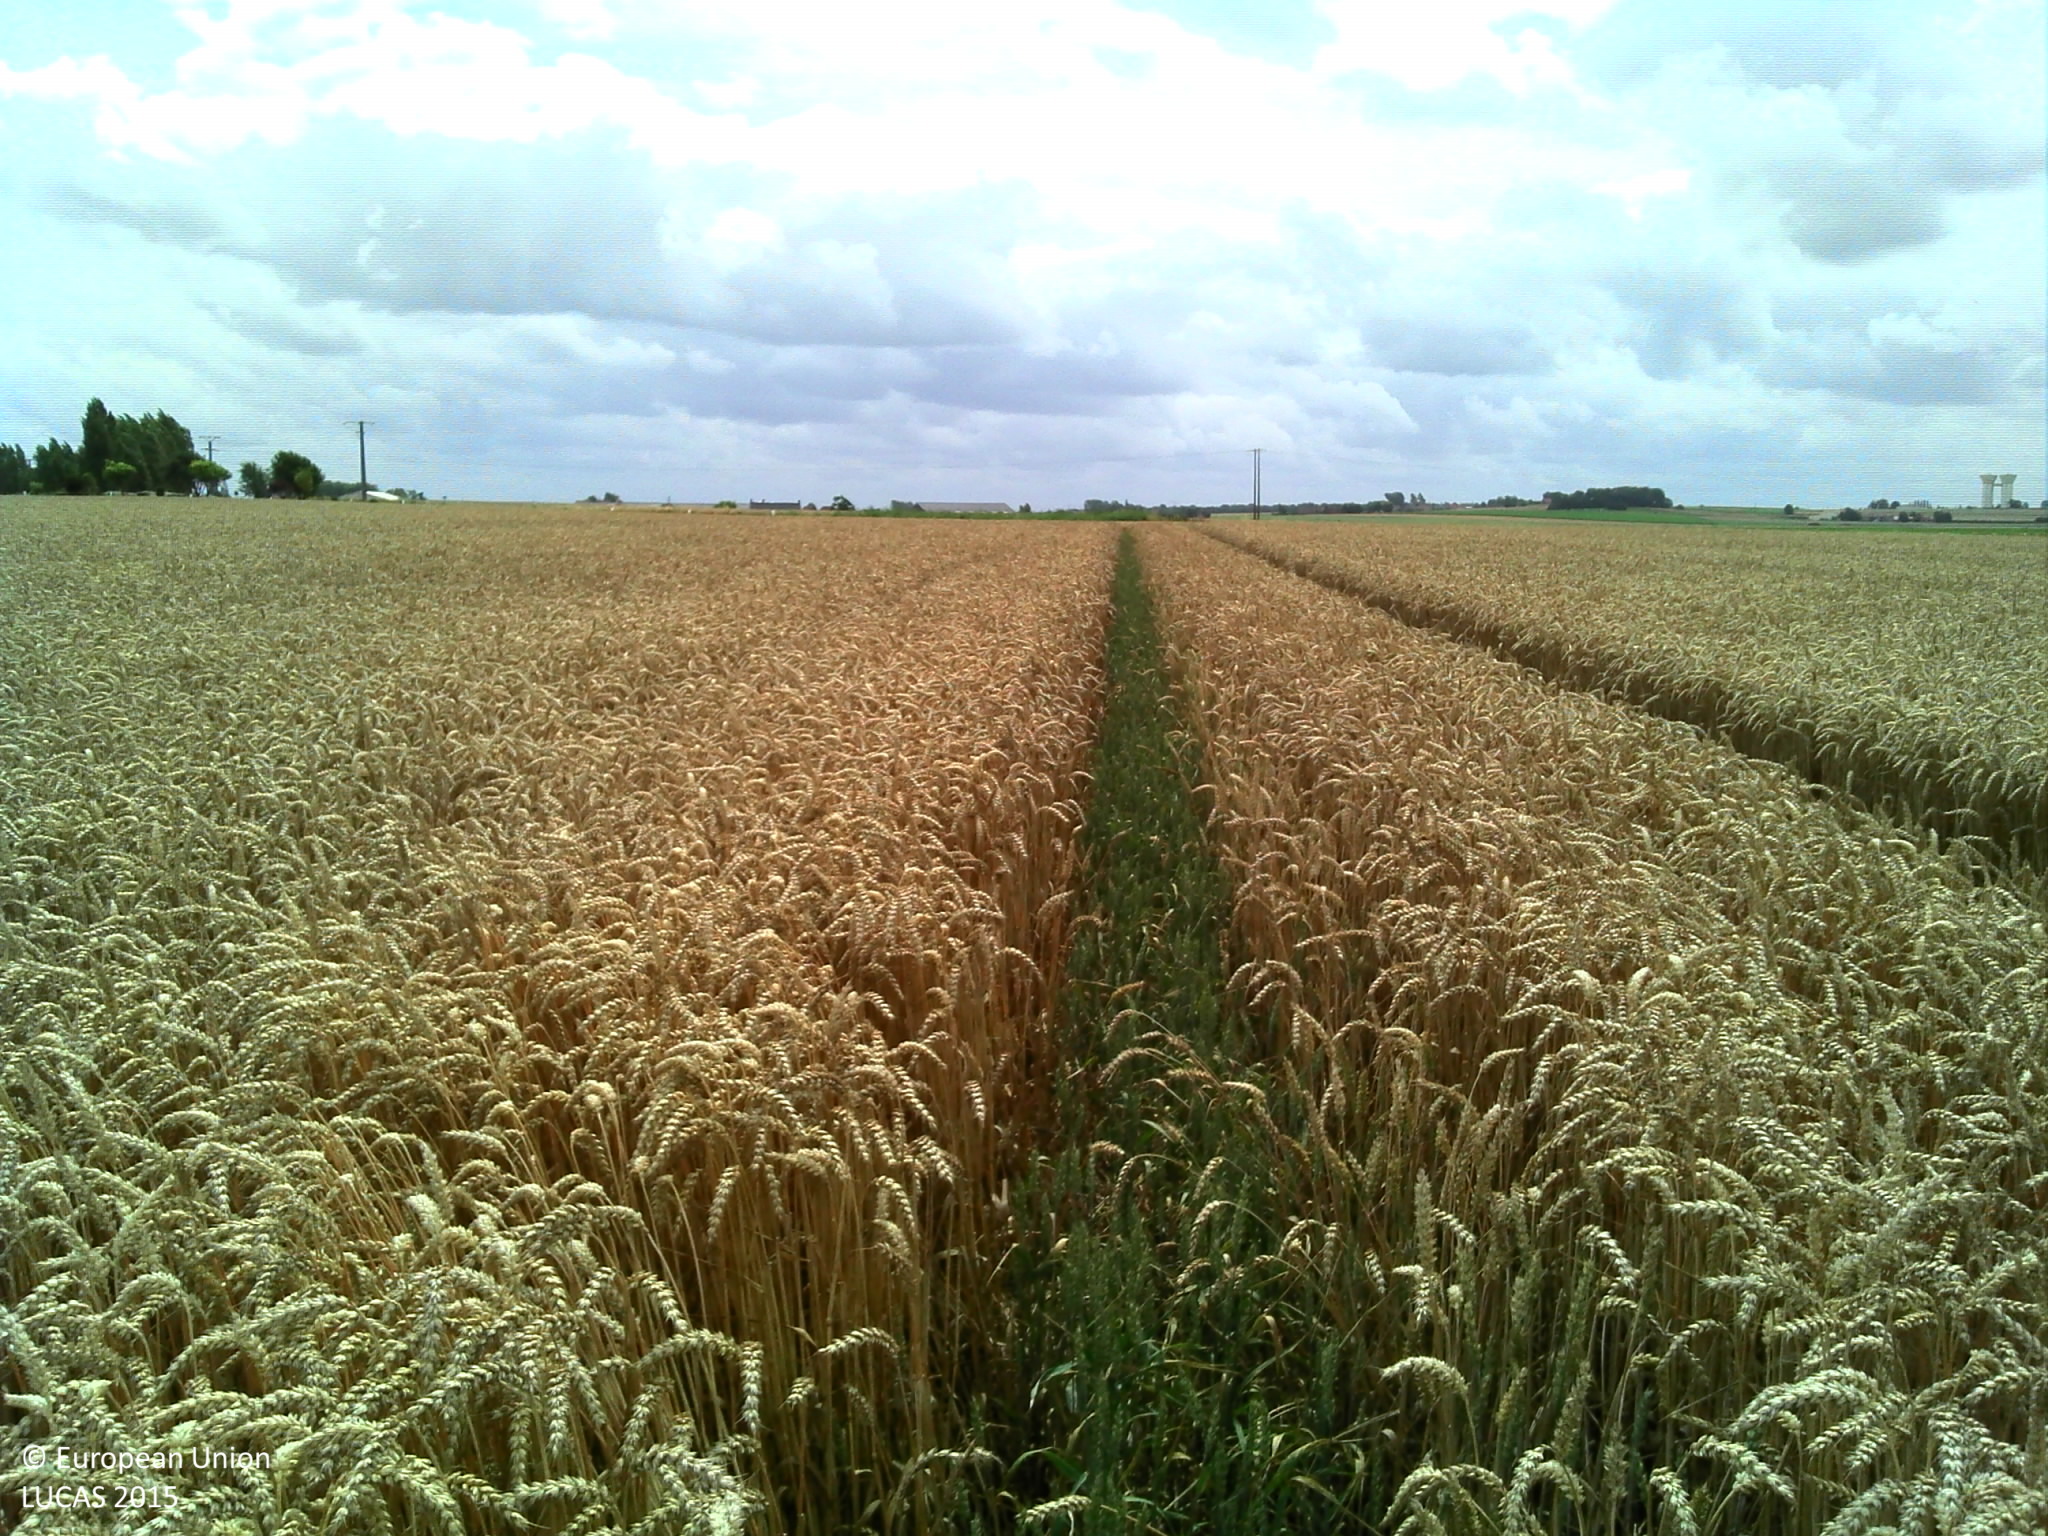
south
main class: Cropland
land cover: Common wheat
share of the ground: > 75 %
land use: Agriculture (excluding fallow land and kitchen gardens)
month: July
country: FR
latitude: 50.7632
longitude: 2.4302
